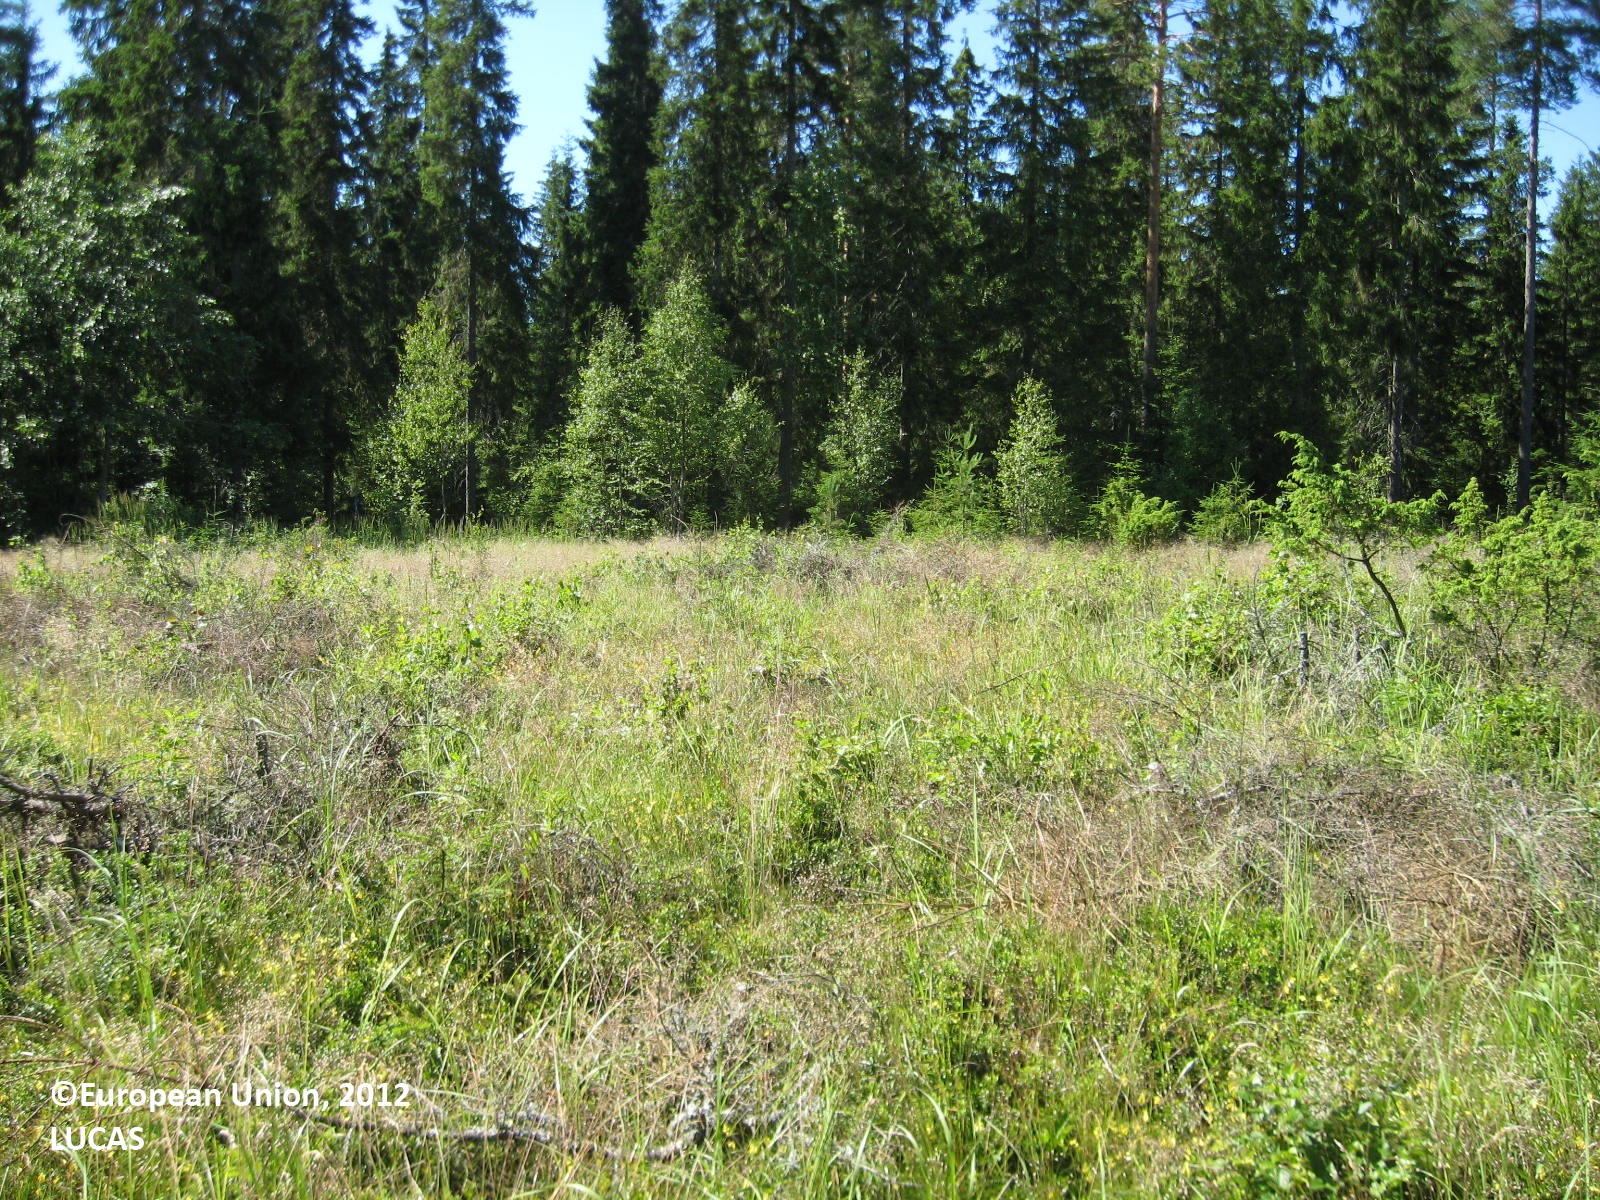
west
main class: Woodland
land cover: Spruce dominated mixed woodland
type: boreal forest
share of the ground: 50 - 75 %
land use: Energy production
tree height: > 5 m
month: July
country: FI
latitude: 62.1578
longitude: 21.6595
